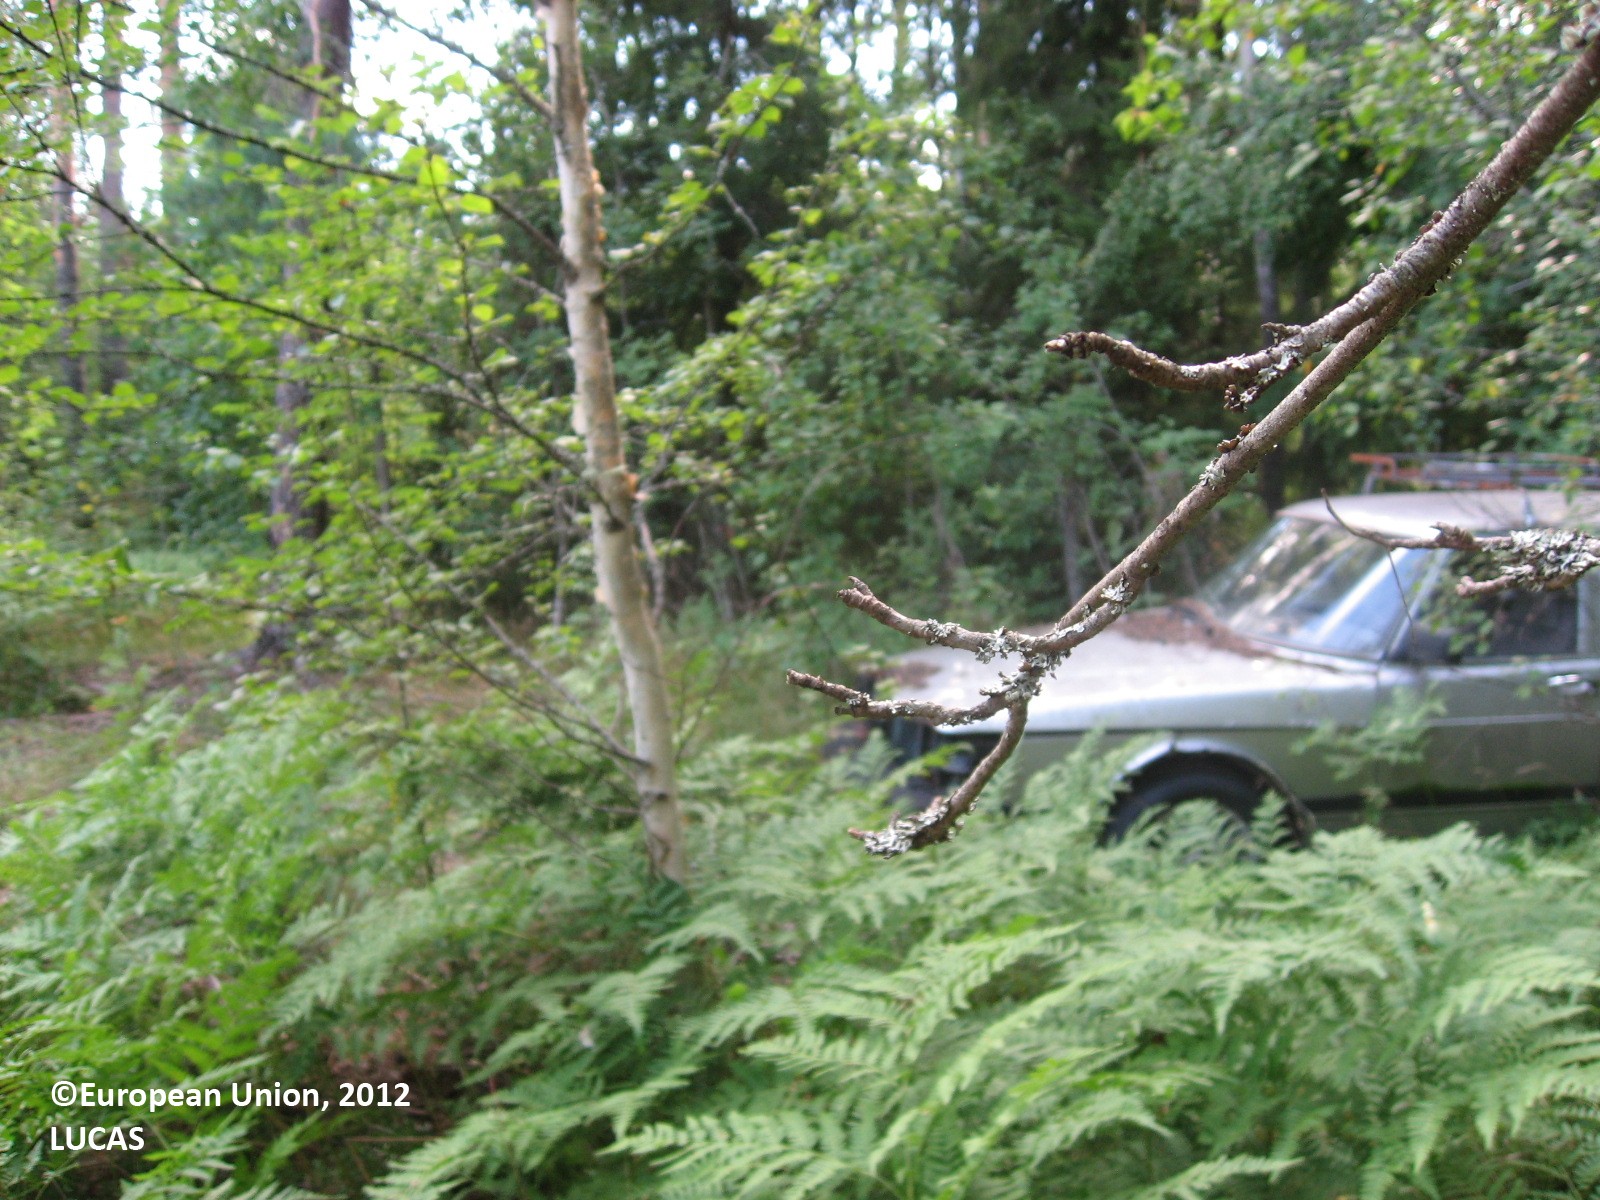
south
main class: Woodland
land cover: Spruce dominated mixed woodland
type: boreal forest
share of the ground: 50 - 75 %
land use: Forestry
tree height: > 5 m
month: August
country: FI
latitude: 60.5959
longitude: 25.4095
